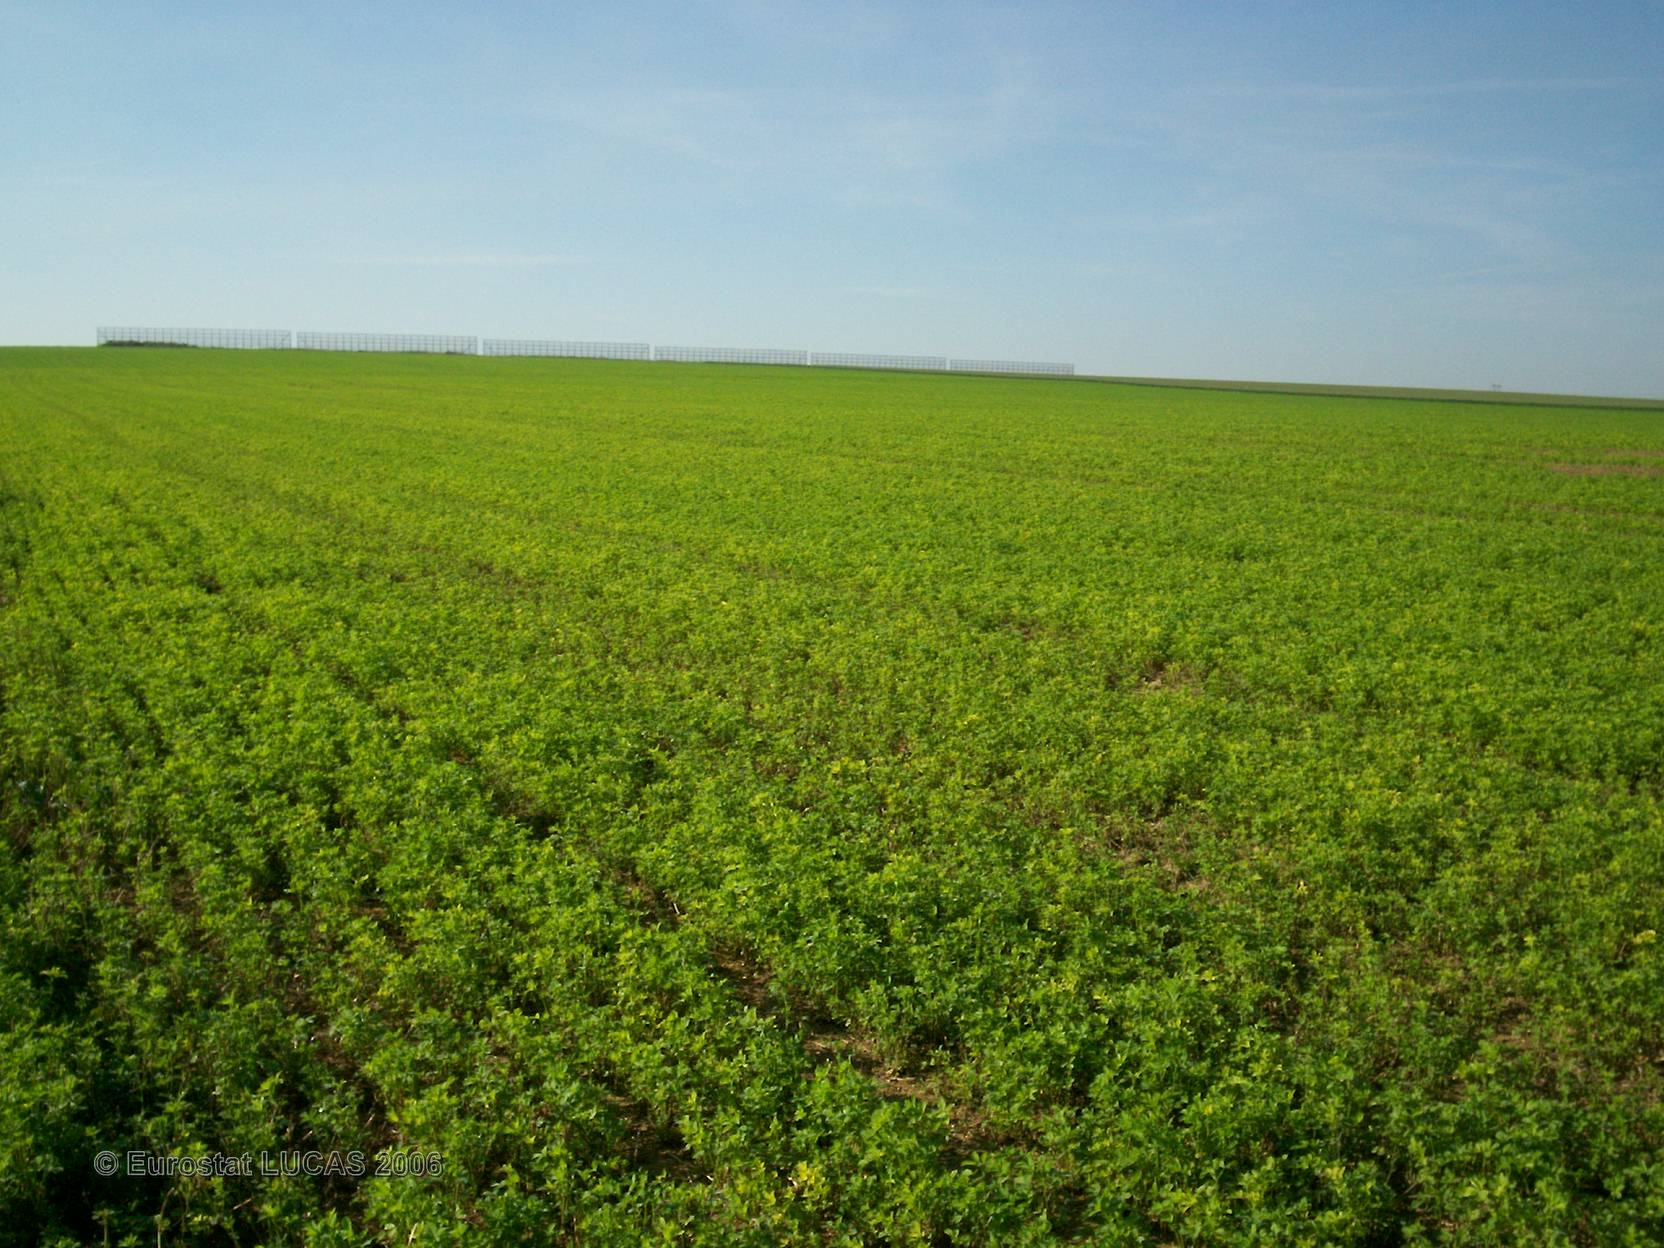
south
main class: Cropland
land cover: Lucerne
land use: Agriculture (excluding fallow land and kitchen gardens)
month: June
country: FR
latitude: 48.8964
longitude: 4.4723
